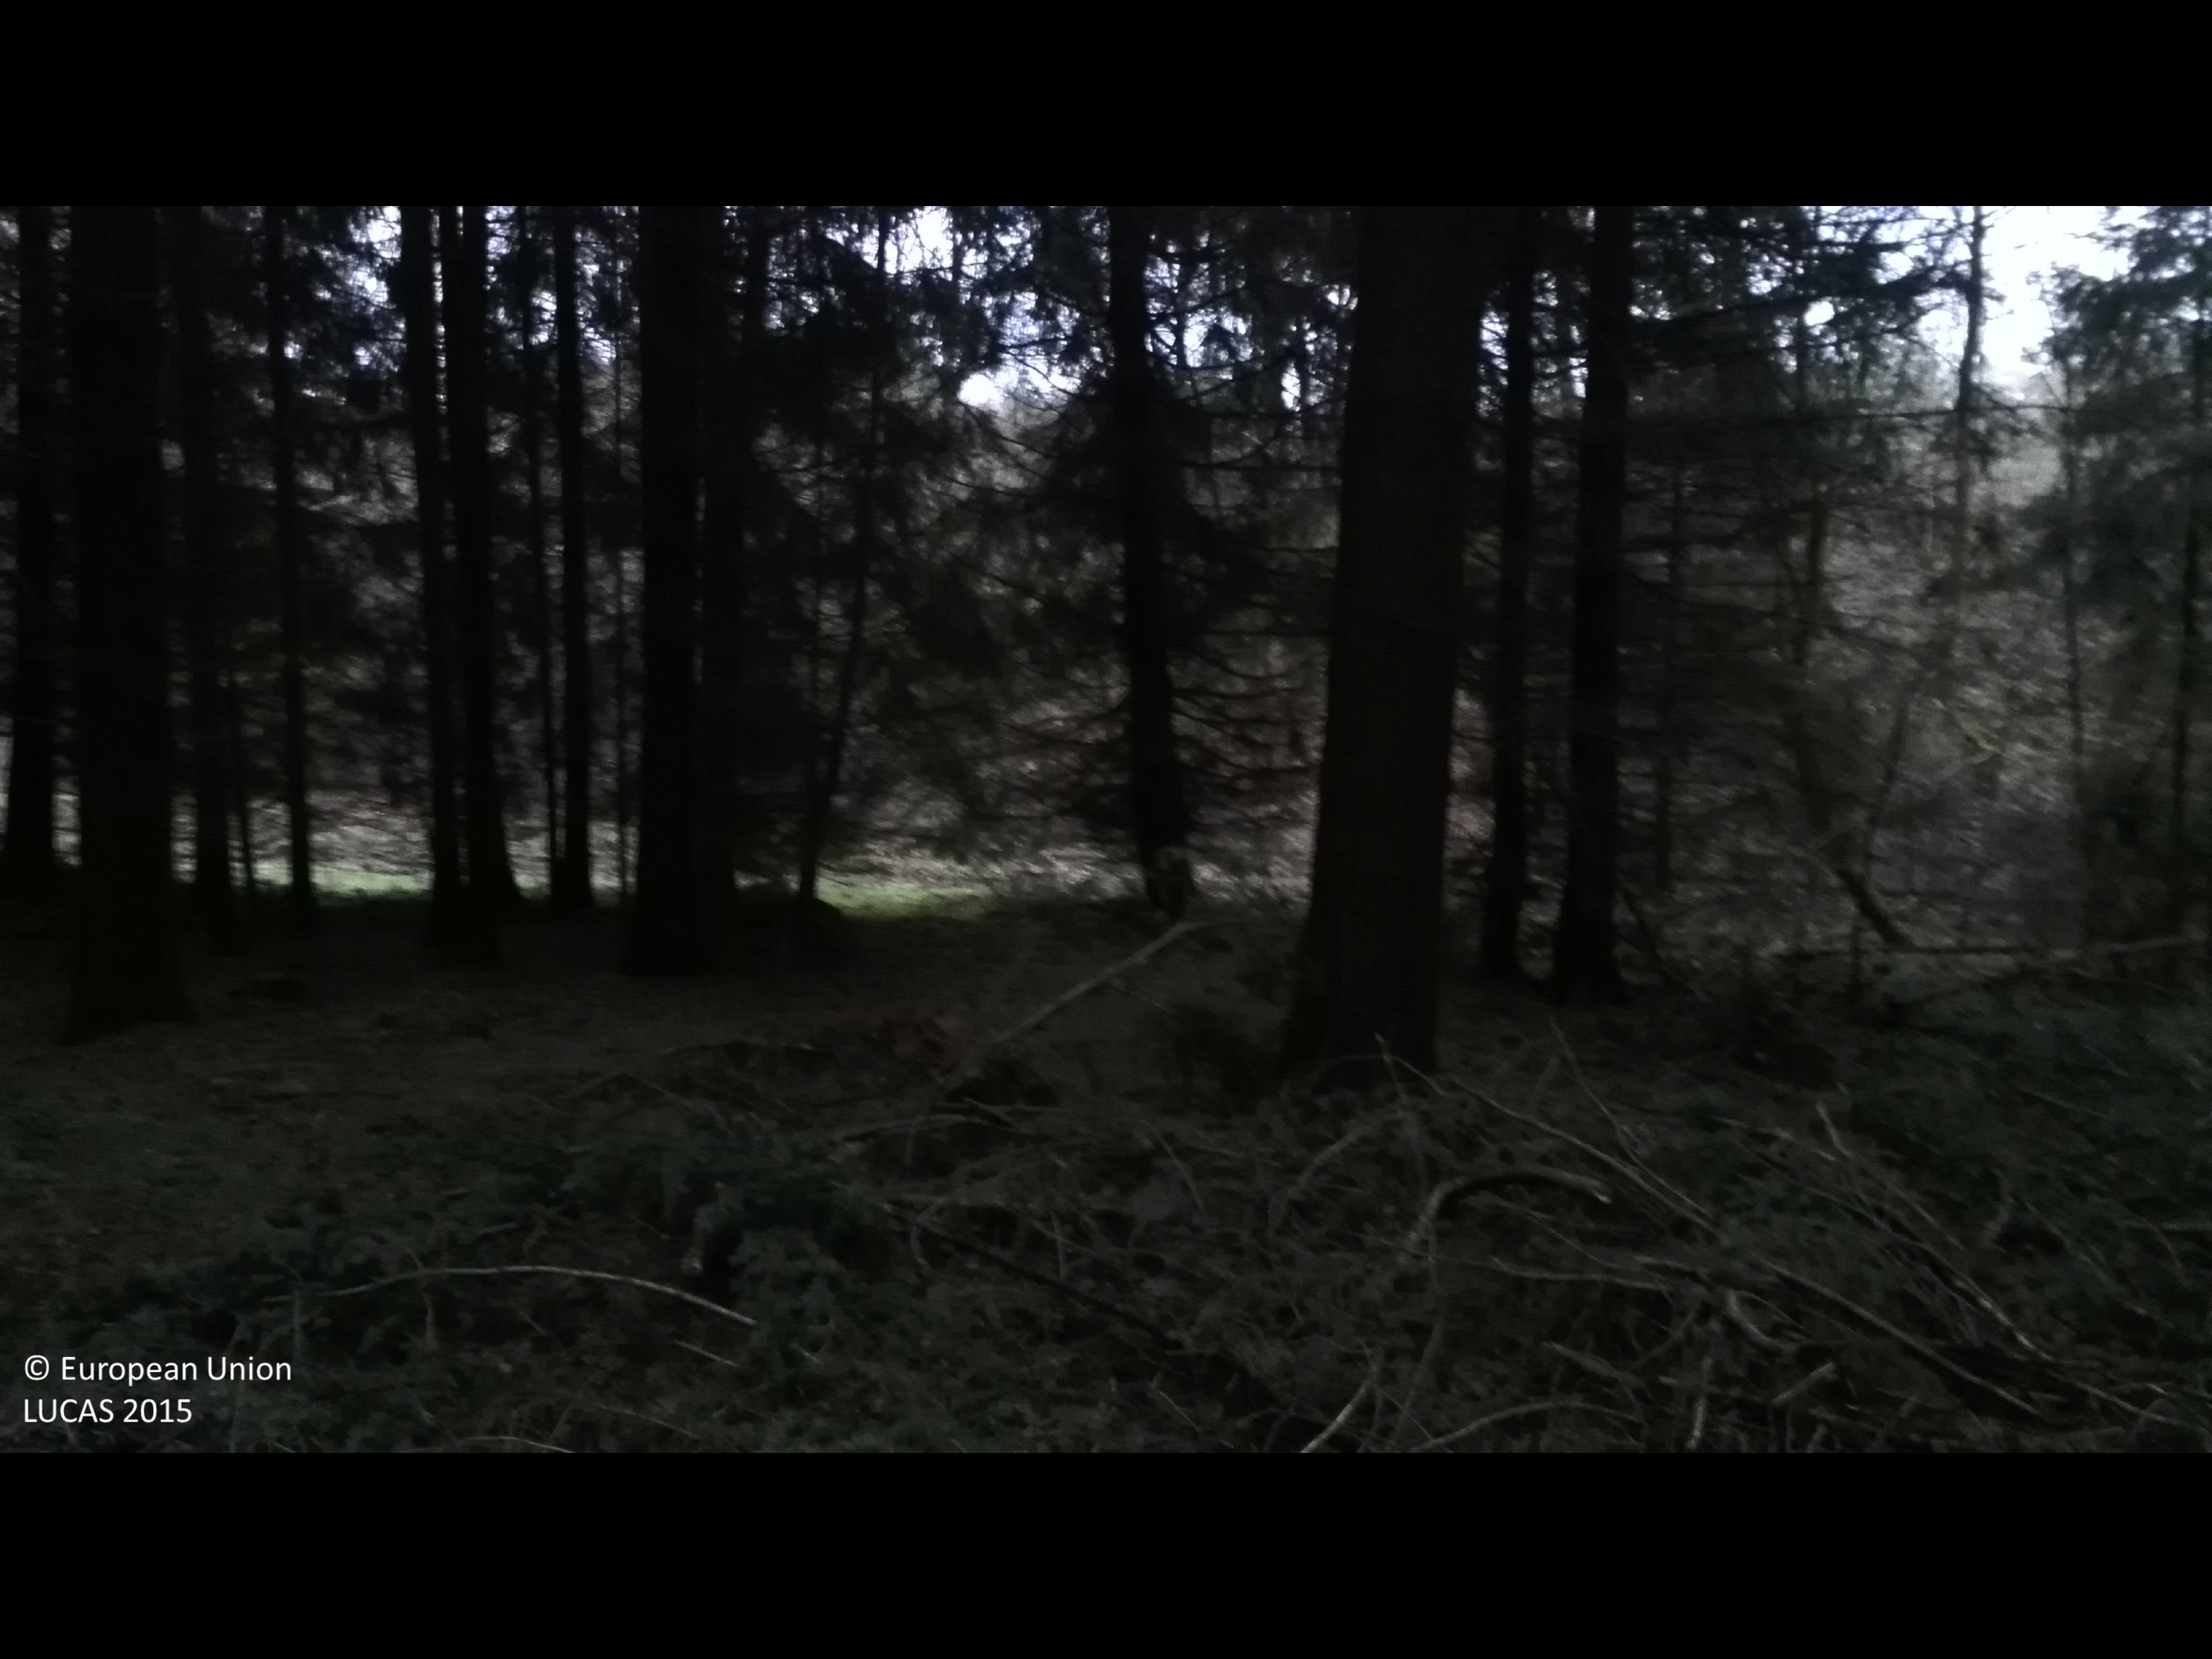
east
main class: Woodland
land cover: Pine dominated coniferous woodland
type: hemiboreal forest and nemoral coniferous forest and mixed broadleaved-coniferous forest
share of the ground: > 75 %
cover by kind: coniferous forest trees 100 %
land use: Forestry
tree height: > 5 m
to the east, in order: Pine dominated coniferous woodland; Grassland without tree/shrub cover; Fences; Broadleaved woodland; Grass margins; Paved roads, cycling and walking lanes; Grassland without tree/shrub cover; Pine dominated mixed woodland; Broadleaved woodland
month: January
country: DE
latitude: 53.4199
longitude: 9.9248
